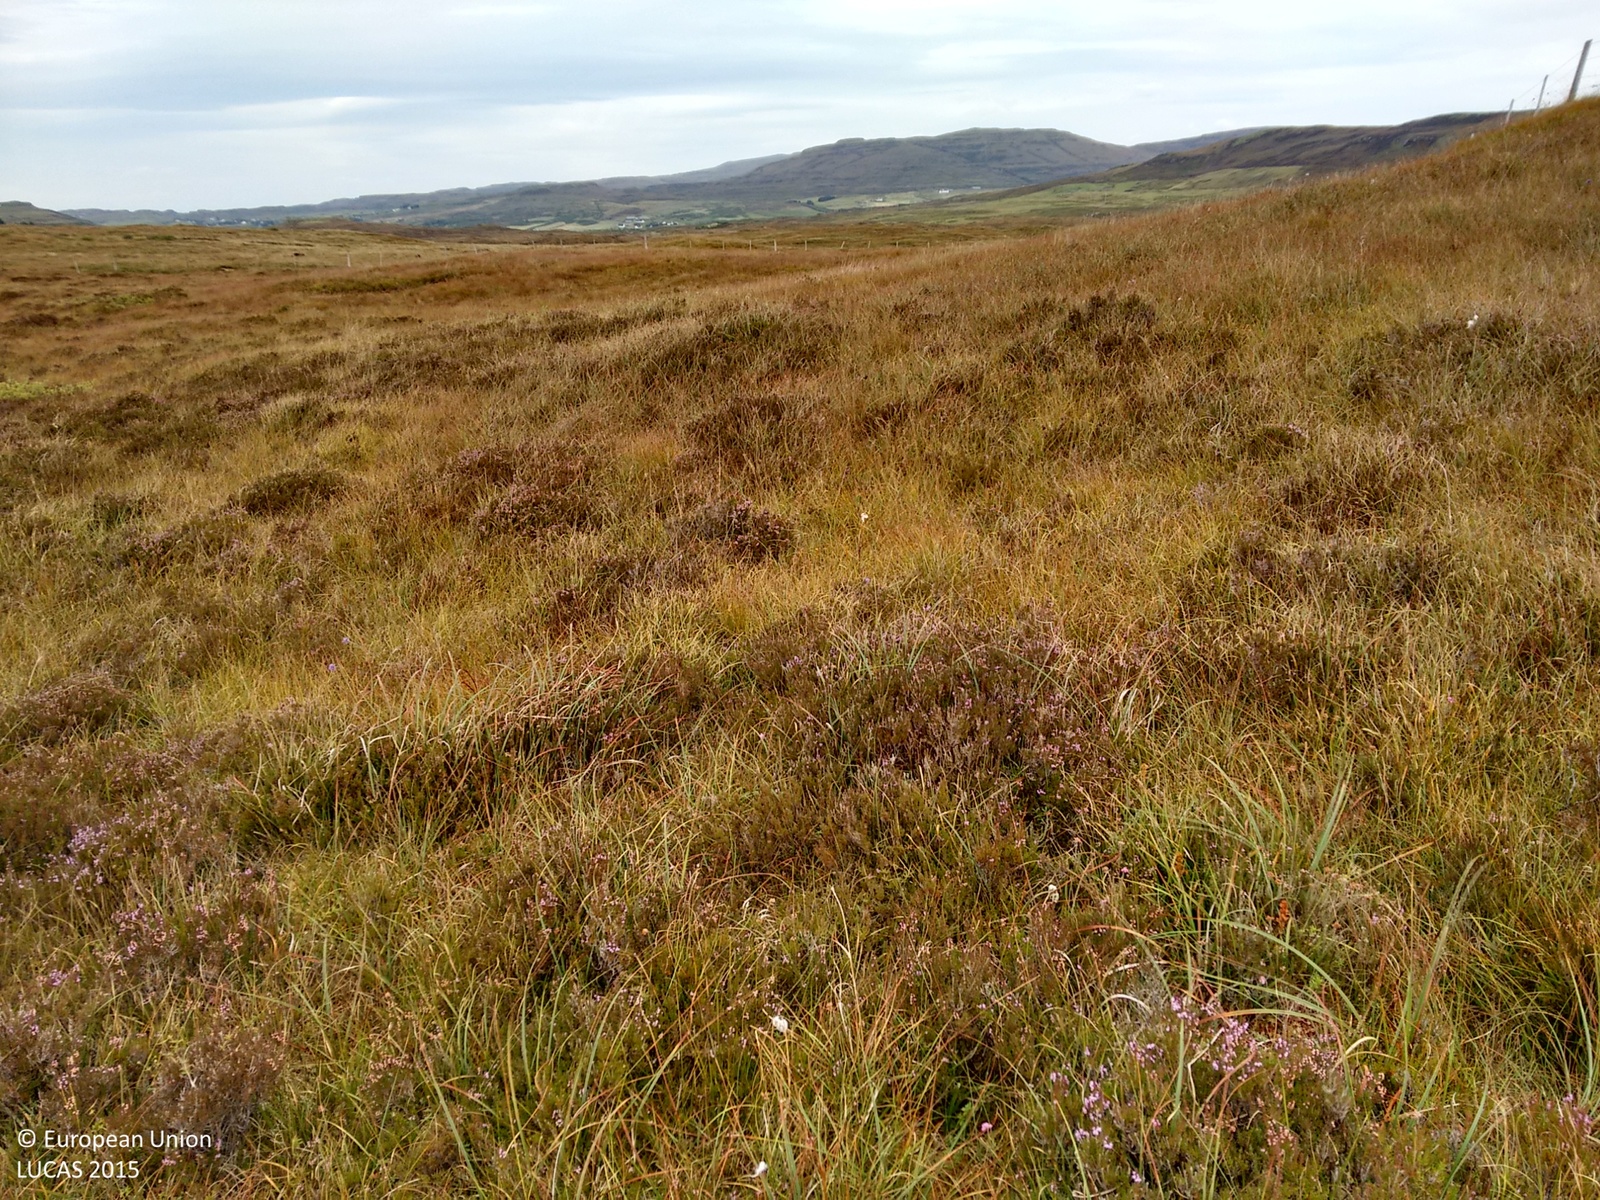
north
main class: Shrubland
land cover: Shrubland without tree cover
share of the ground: > 75 %
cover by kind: shrubs 80 %, herbaceous plants 20 %
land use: Agriculture (excluding fallow land and kitchen gardens)
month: September
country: GB
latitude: 57.4549
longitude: -6.2867
